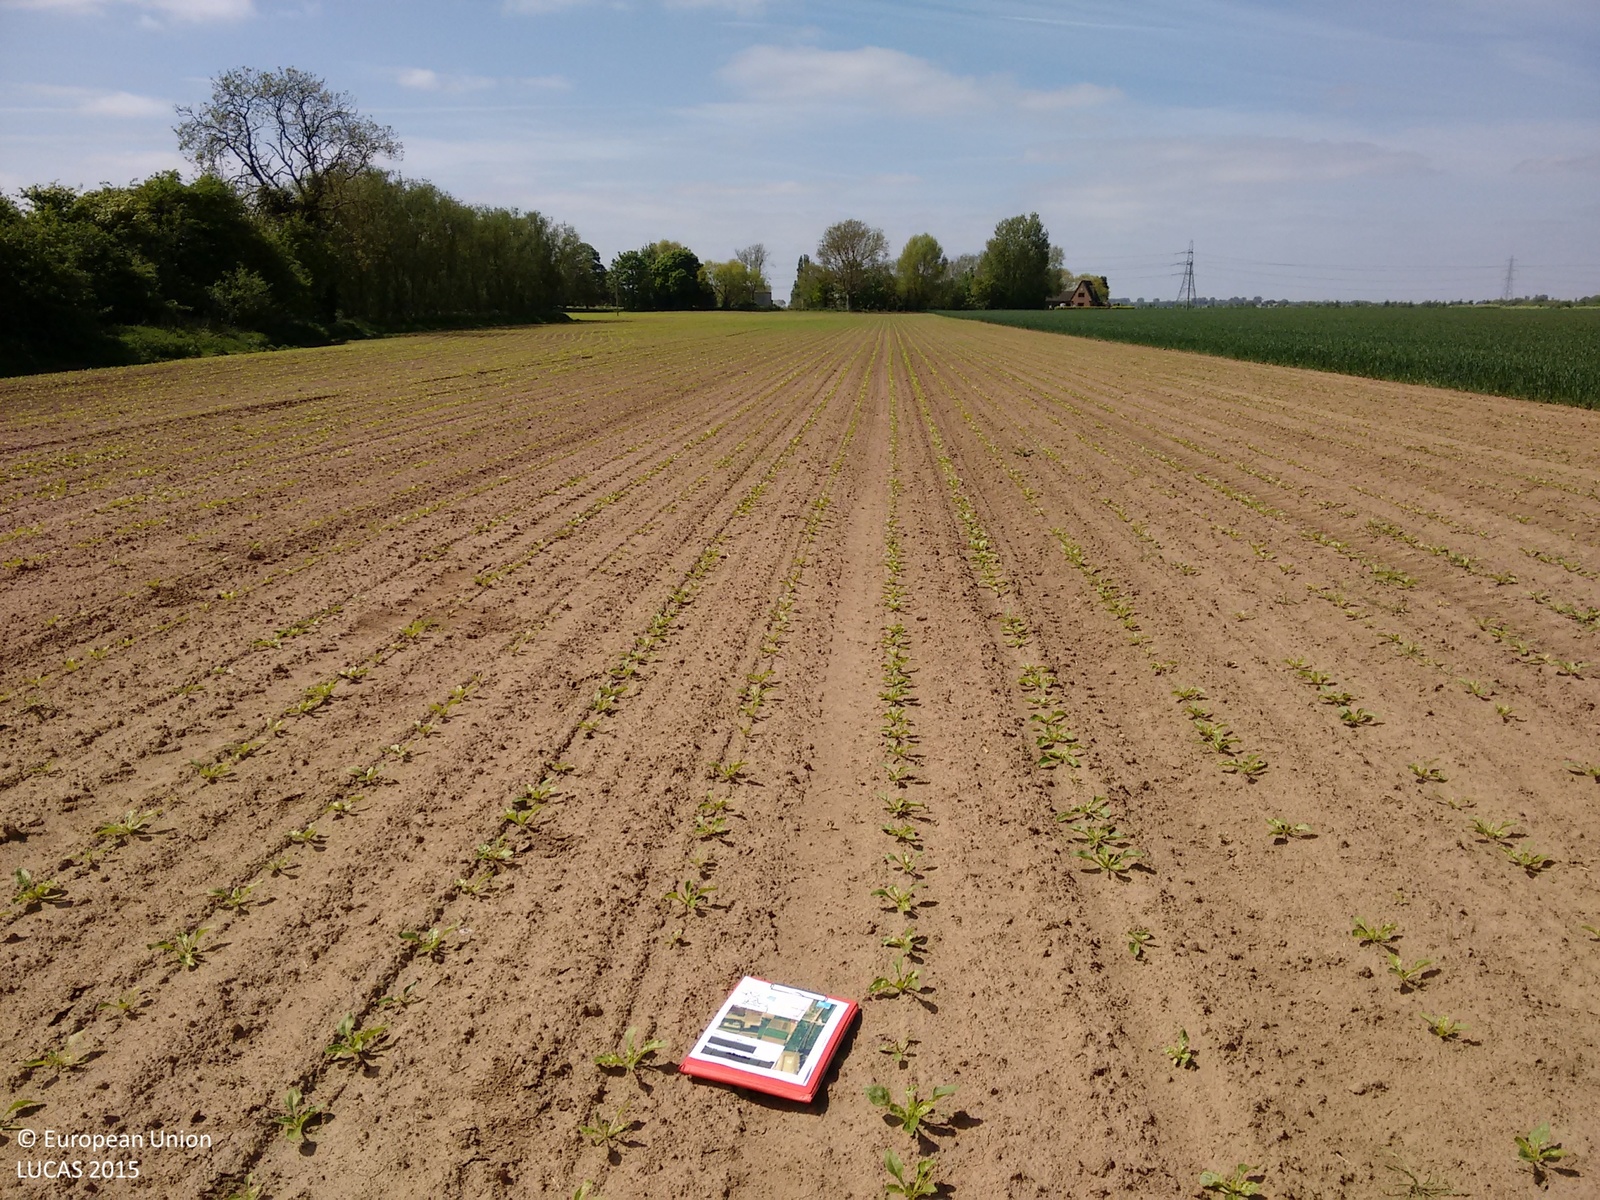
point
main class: Cropland
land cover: Sugar beet
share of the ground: < 10 %
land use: Agriculture (excluding fallow land and kitchen gardens)
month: May
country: GB
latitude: 52.8376
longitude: -0.0532
